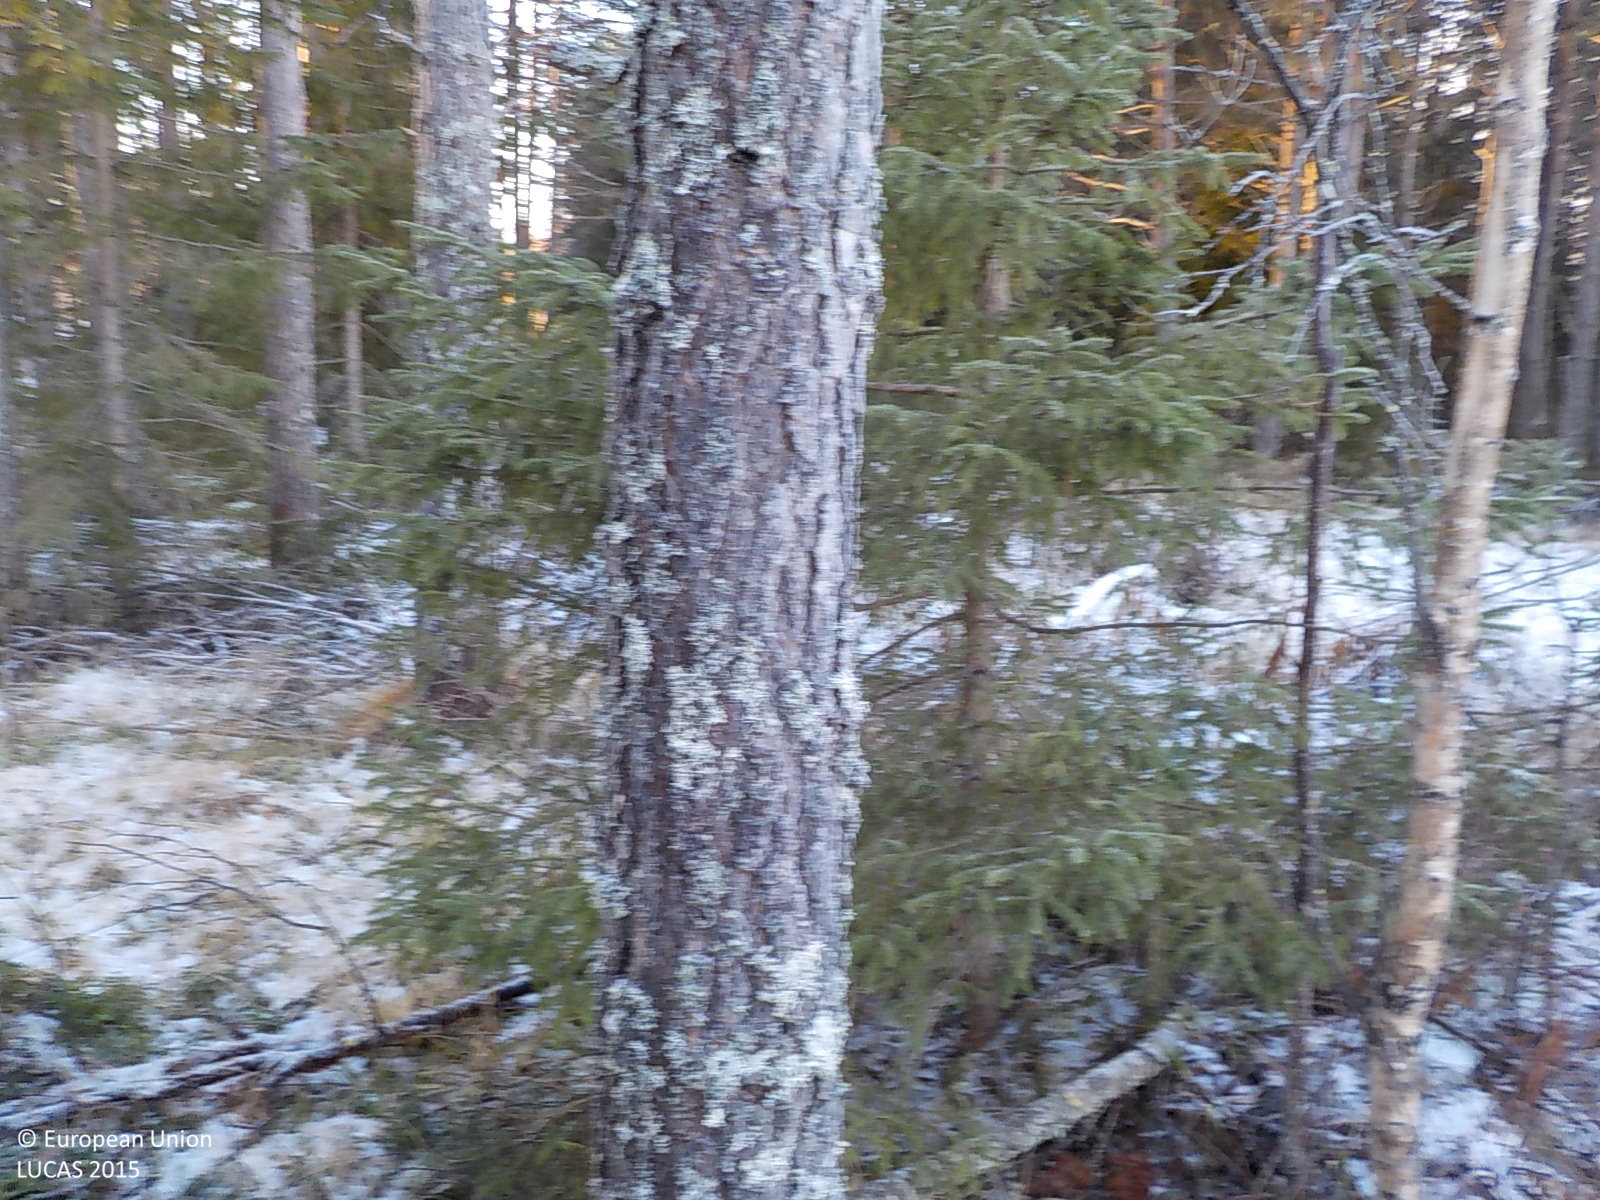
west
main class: Woodland
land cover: Pine dominated coniferous woodland
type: boreal forest
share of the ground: > 75 %
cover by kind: coniferous forest trees 75 %, shrubs 10 %, herbaceous plants 10 %, lichens and mosses 5 %
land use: Forestry
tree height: > 5 m
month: December
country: SE
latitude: 63.2981
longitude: 16.6572
